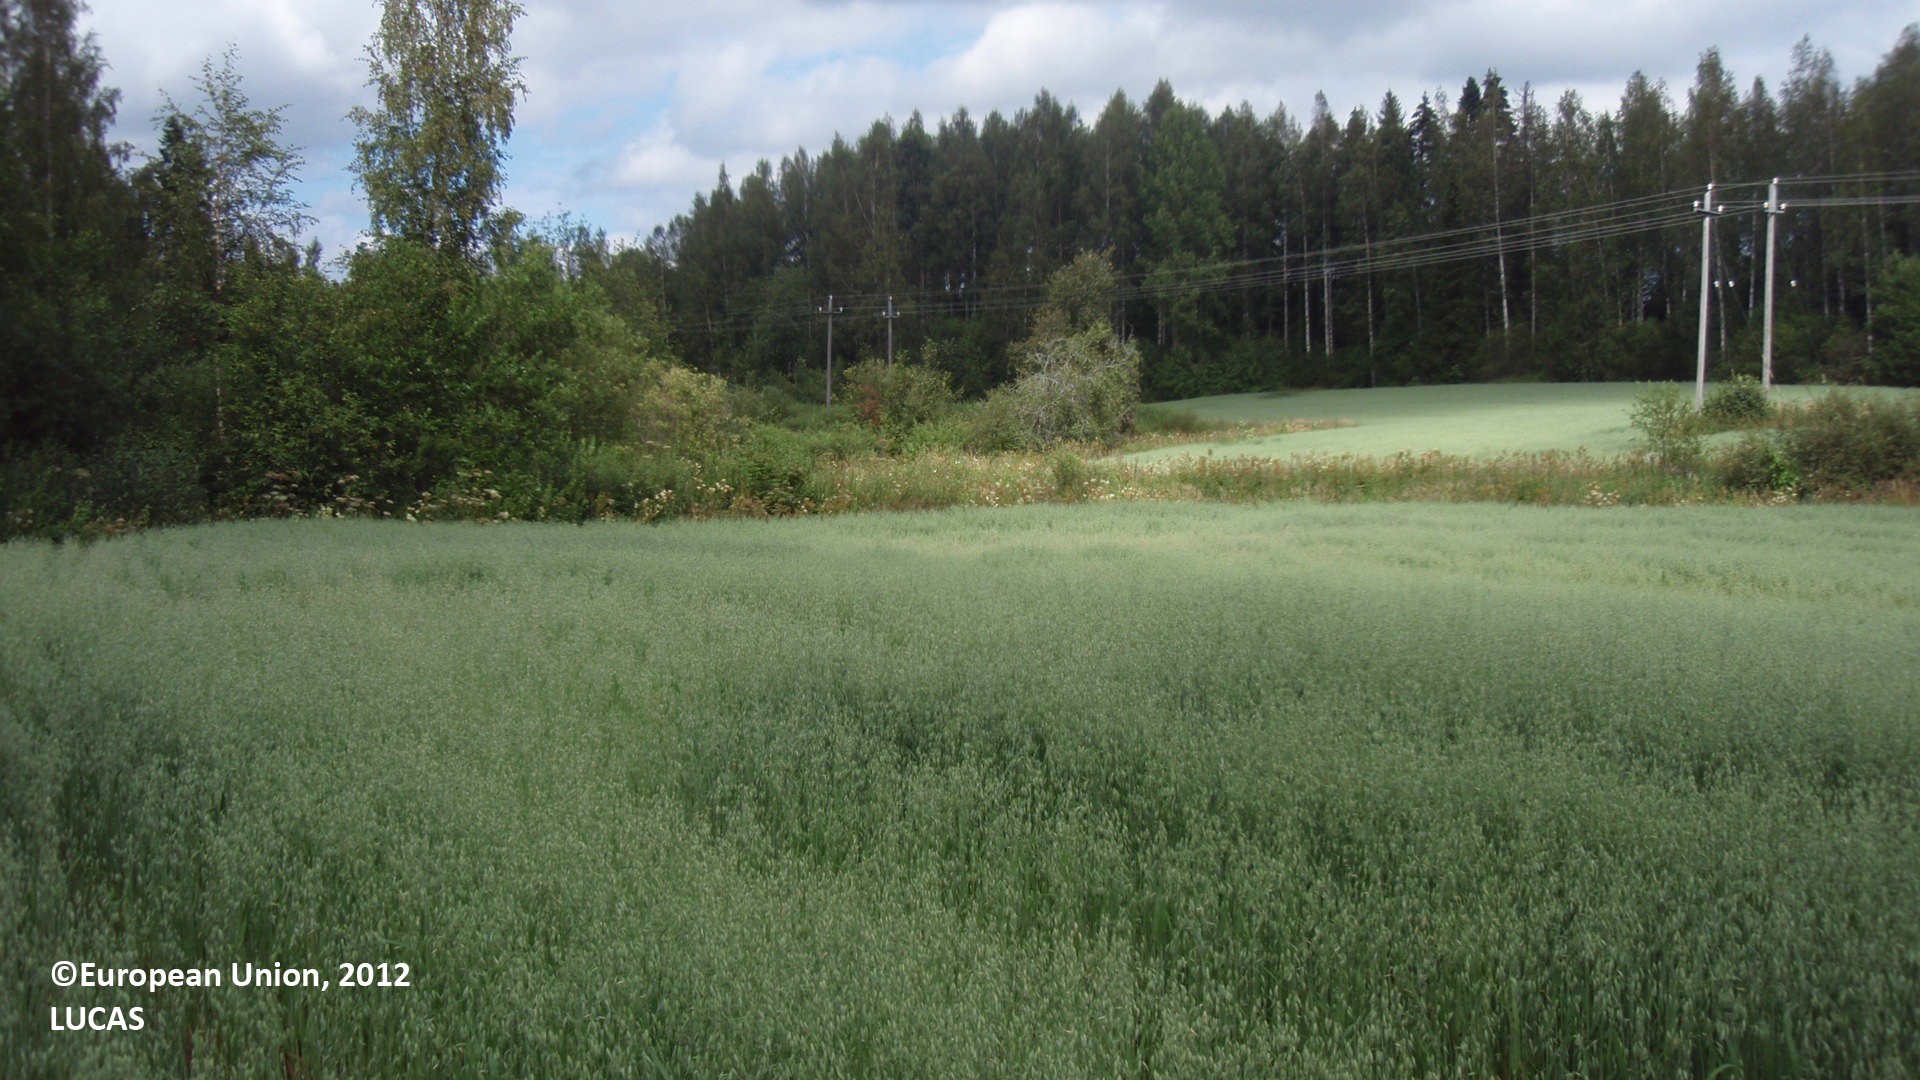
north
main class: Cropland
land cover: Oats
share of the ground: > 75 %
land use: Agriculture (excluding fallow land and kitchen gardens)
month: July
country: FI
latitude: 61.0059
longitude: 28.4694
